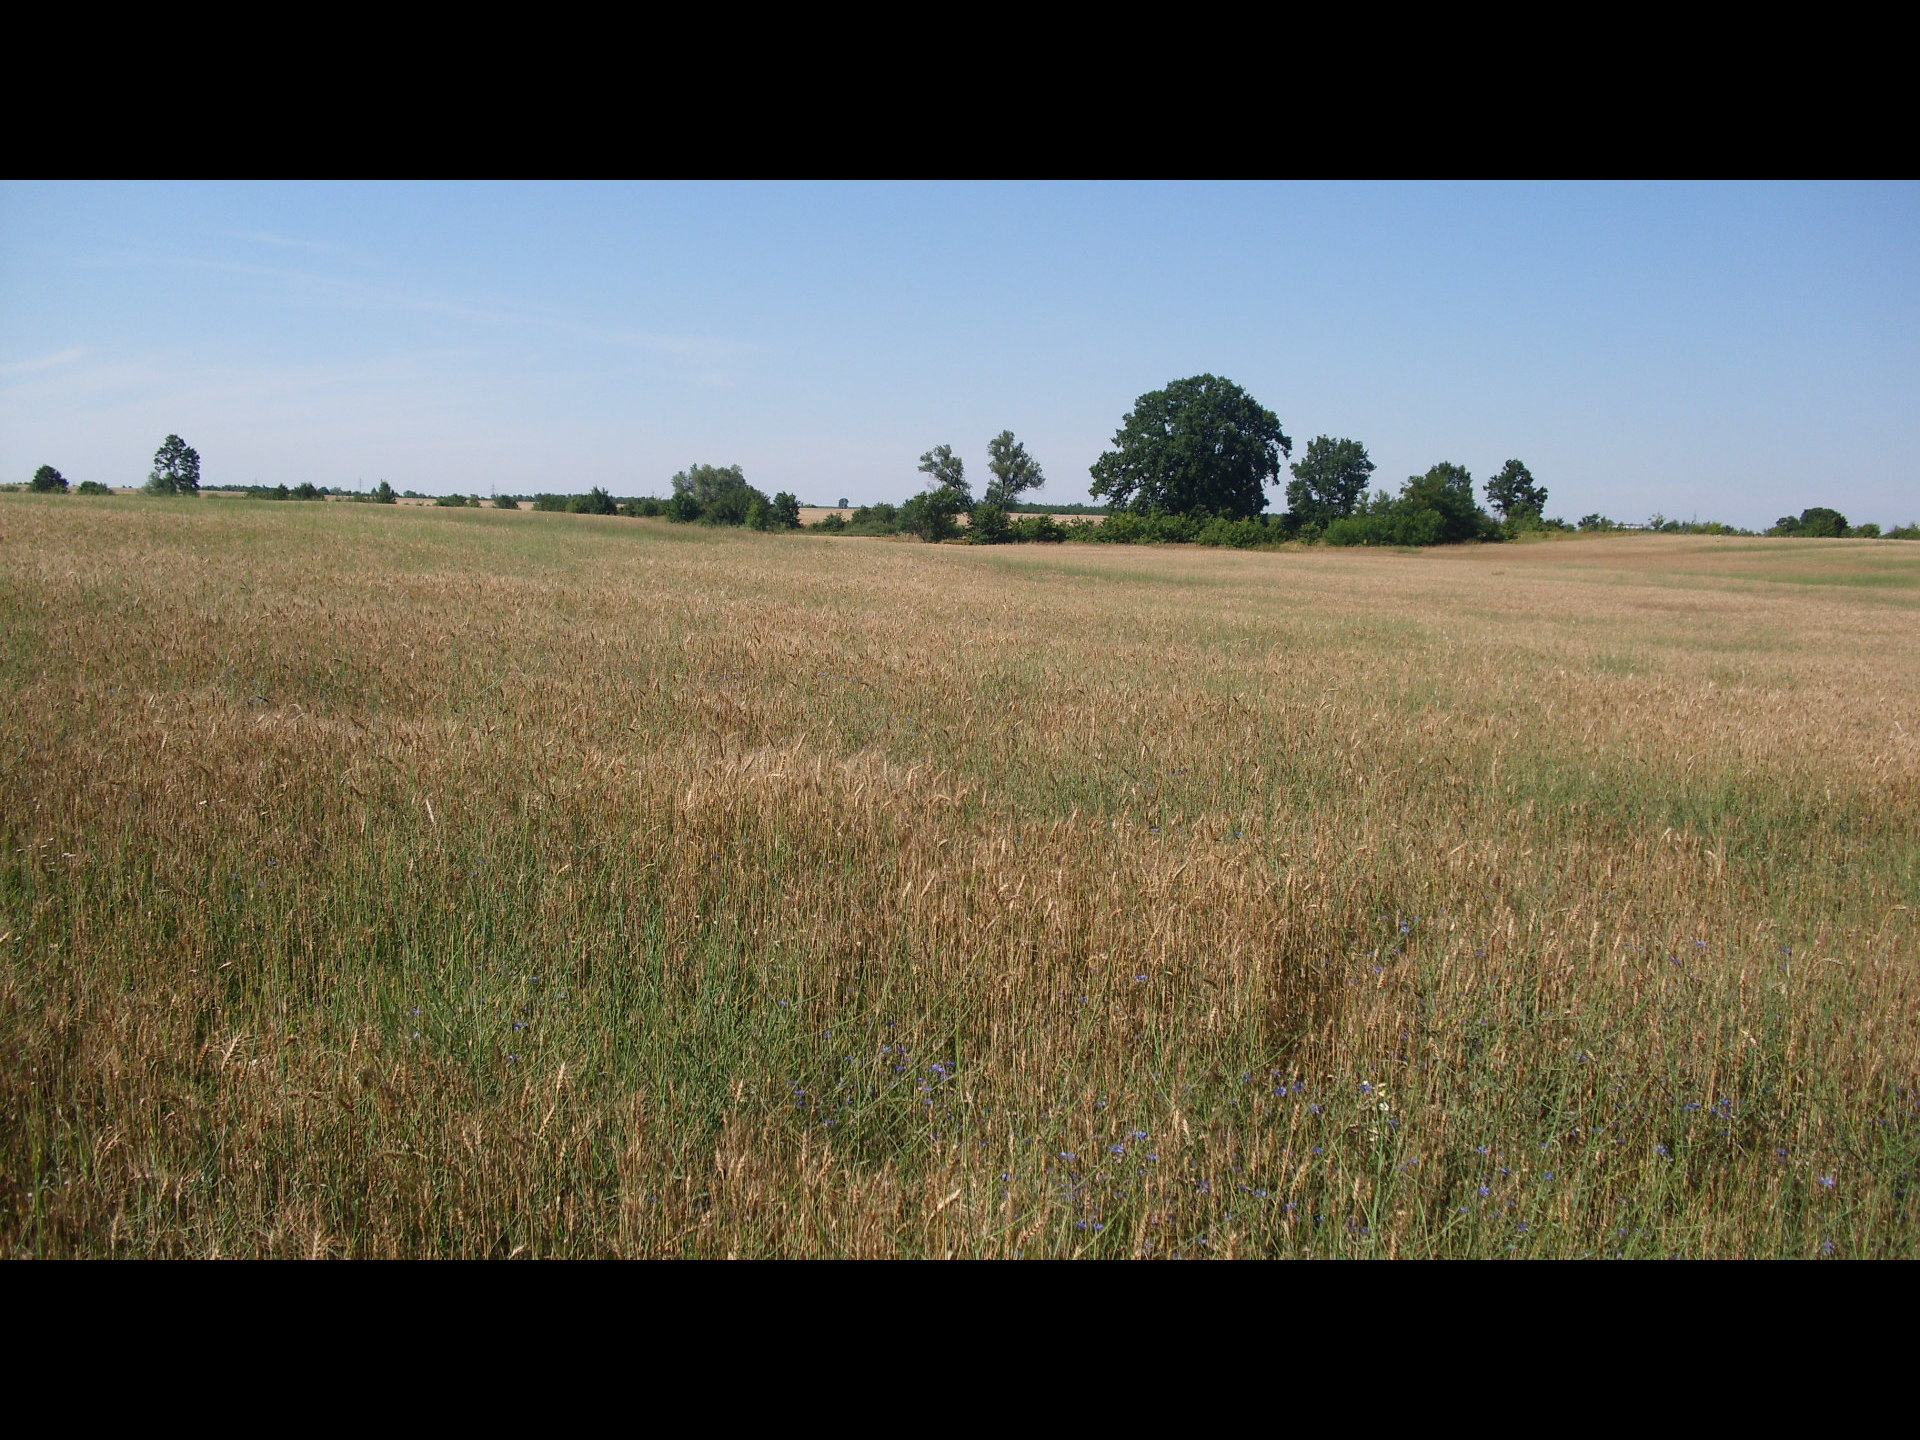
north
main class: Cropland
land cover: Common wheat
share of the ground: > 75 %
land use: Agriculture (excluding fallow land and kitchen gardens)
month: June
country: BG
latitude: 43.5579
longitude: 23.1998
